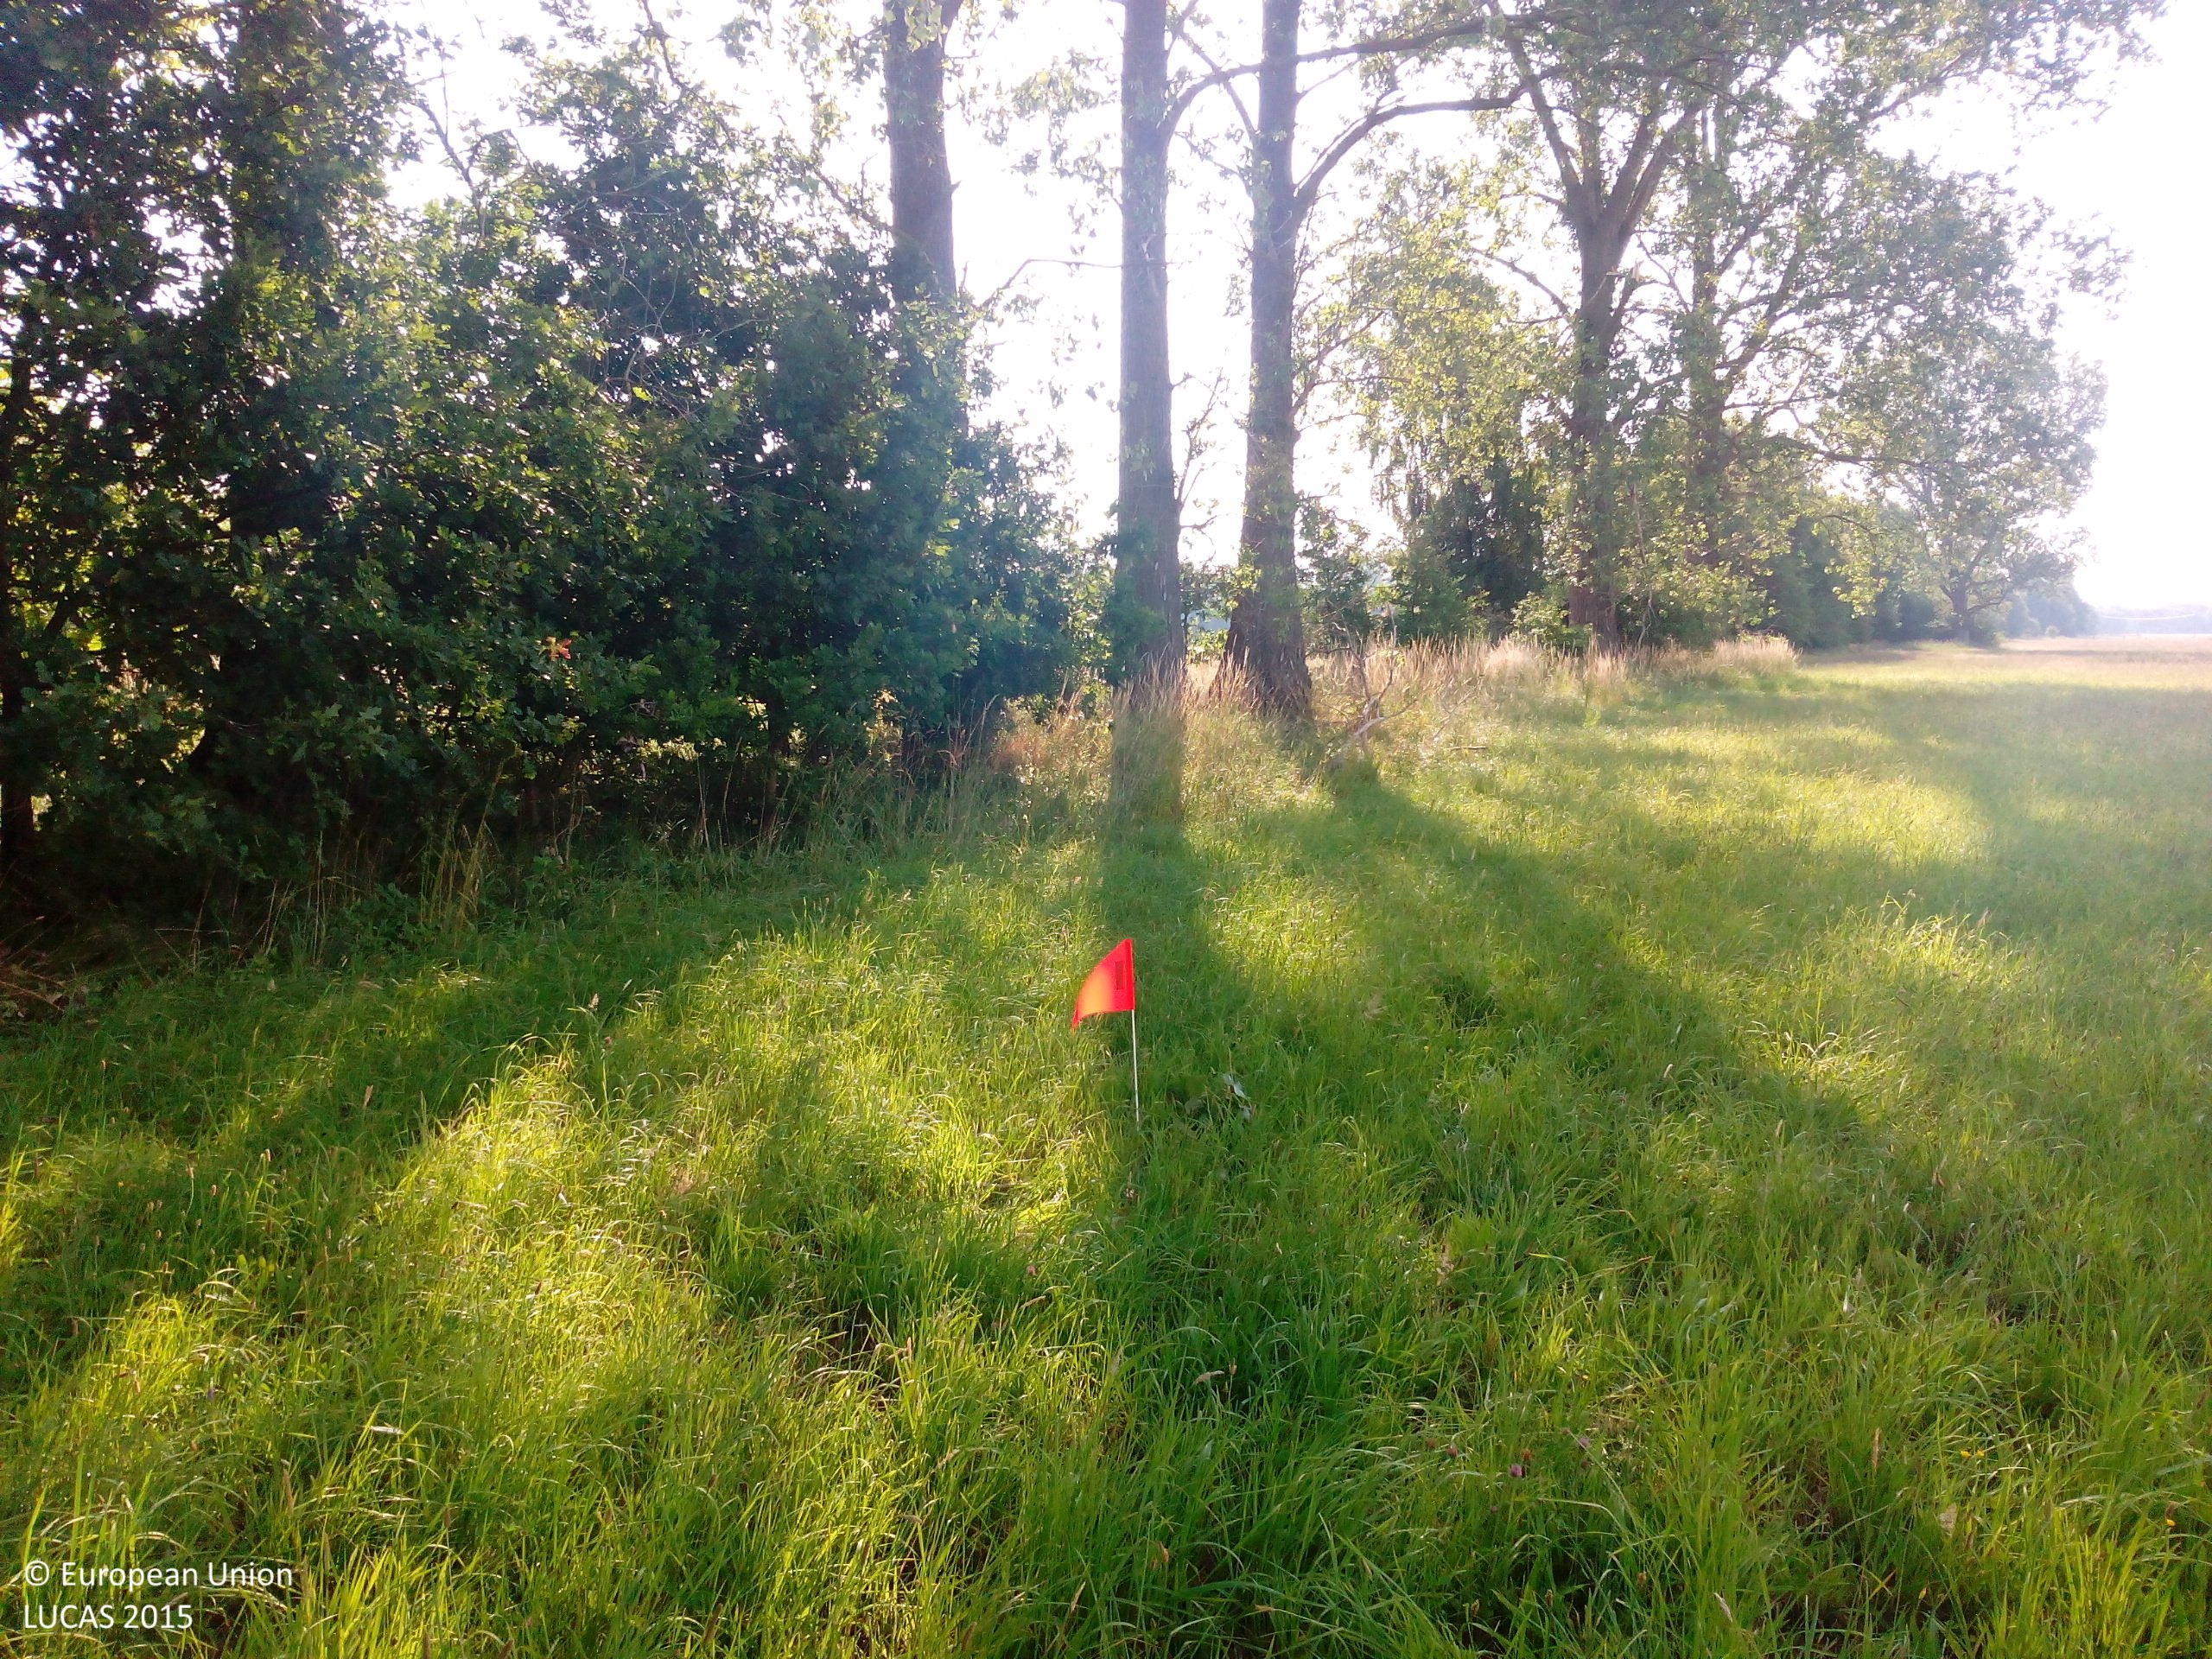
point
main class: Grassland
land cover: Grassland without tree/shrub cover
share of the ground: > 75 %
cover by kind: herbaceous plants 100 %
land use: Agriculture (excluding fallow land and kitchen gardens)
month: July
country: DE
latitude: 52.4979
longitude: 11.1338
